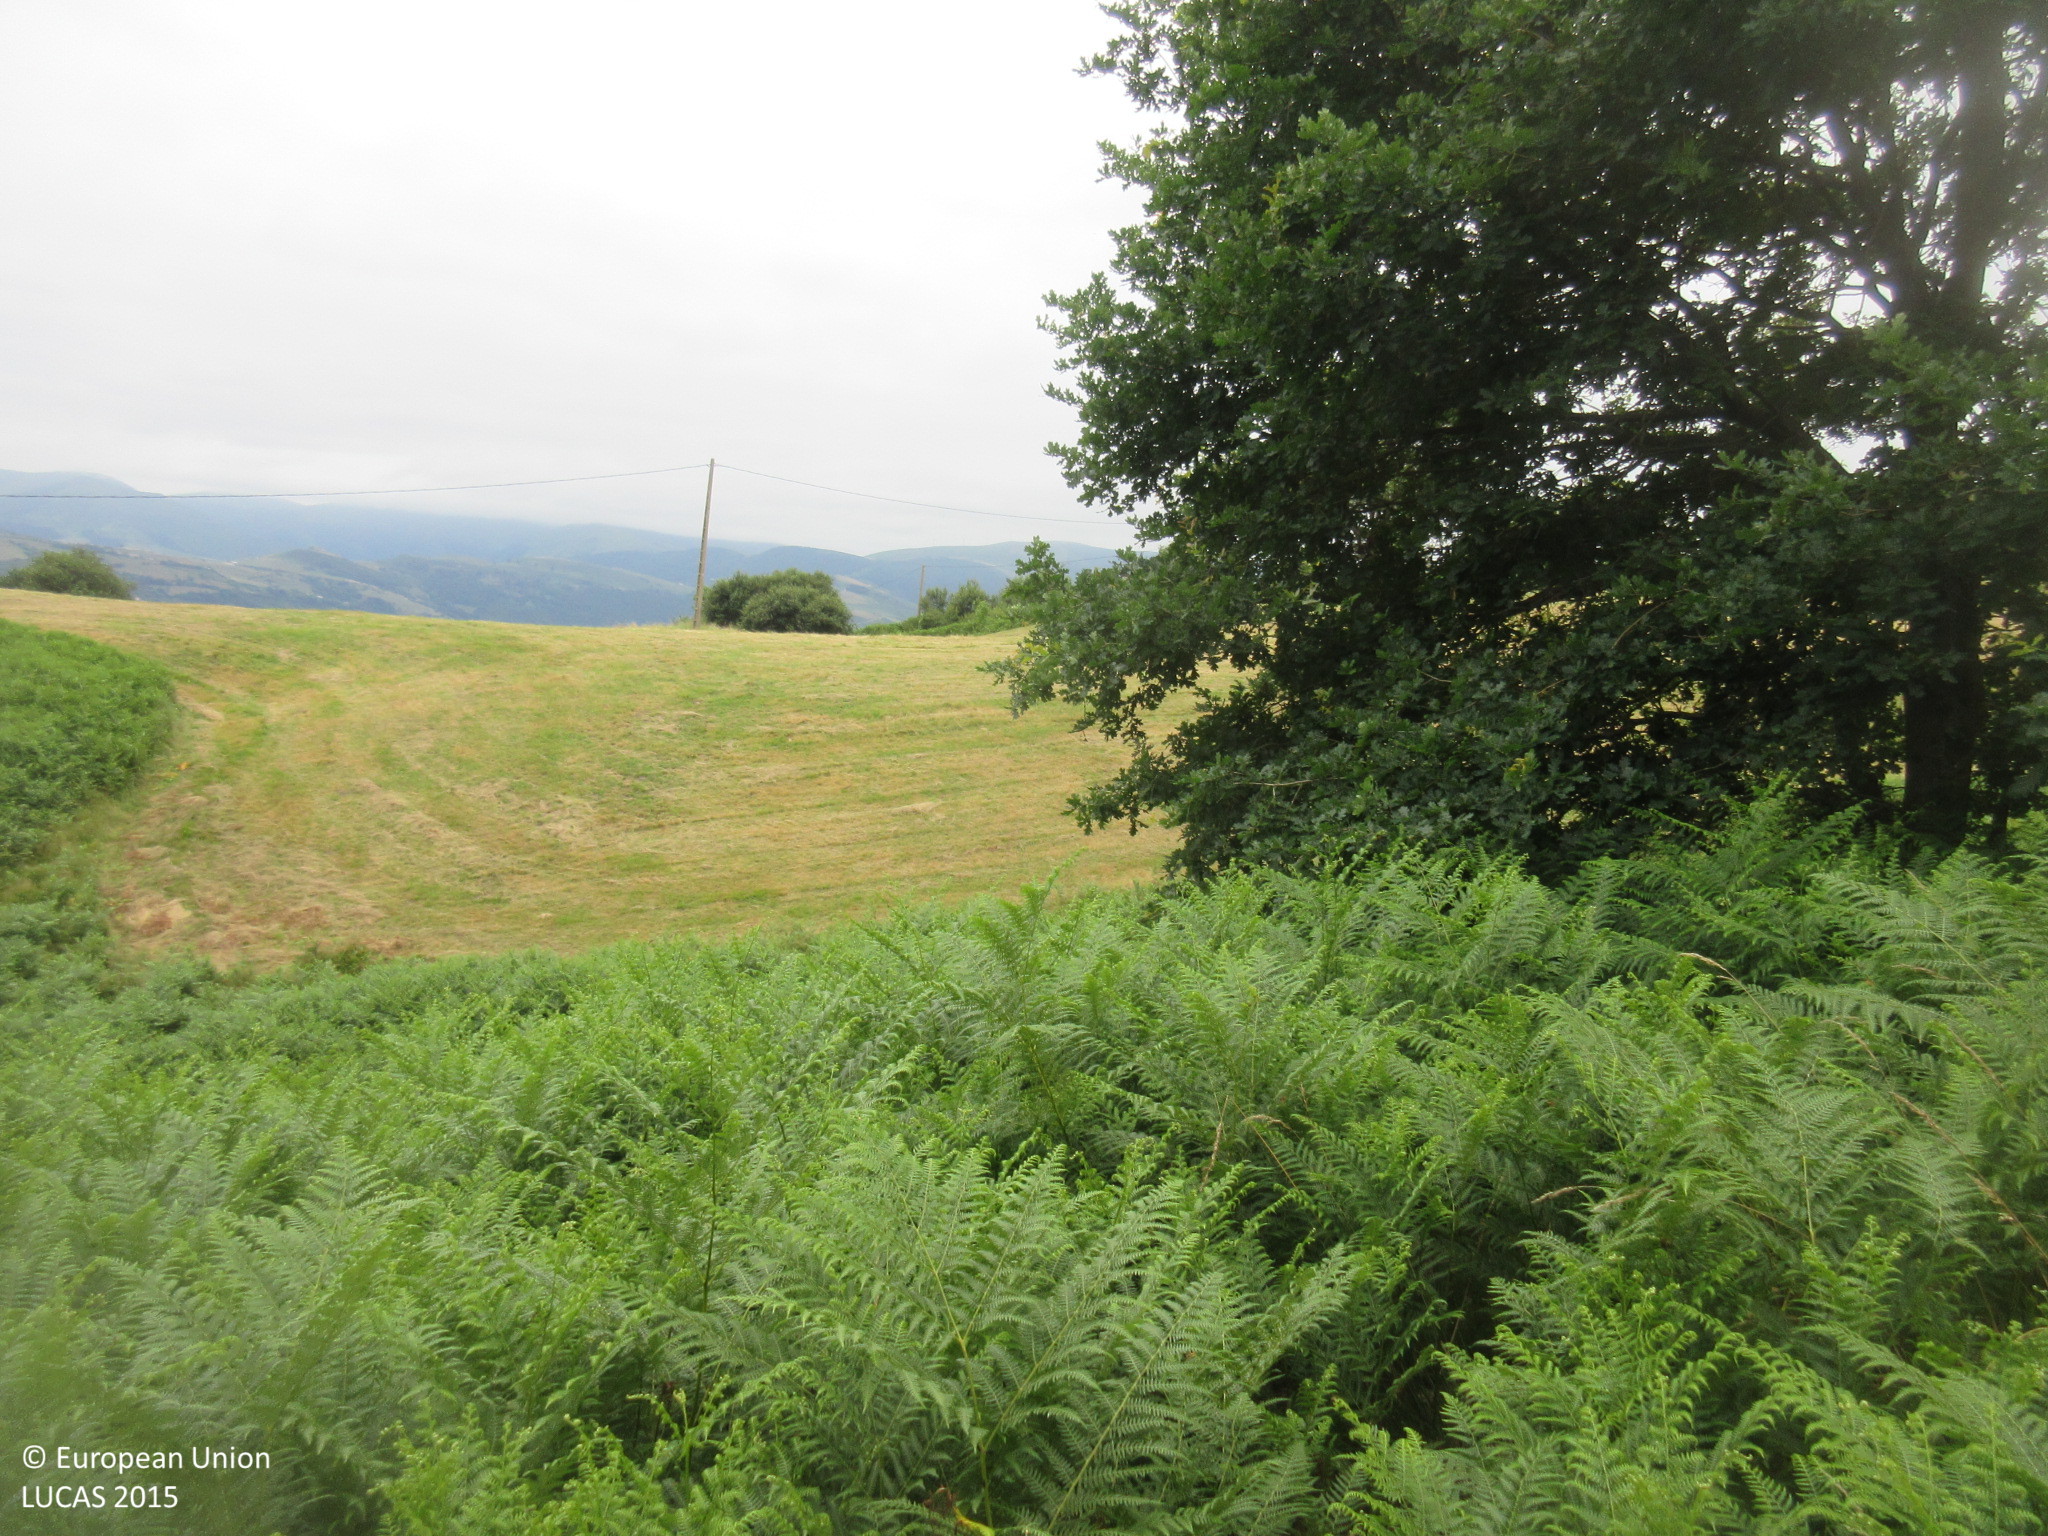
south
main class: Woodland
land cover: Broadleaved woodland
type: acidophilous oak and oak-birch forest
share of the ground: 25 - 50 %
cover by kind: herbaceous plants 60 %, broadleaved forest trees 40 %
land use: Semi-natural and natural areas not in use
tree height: > 5 m
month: July
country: ES
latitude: 43.2263
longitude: -3.4991
